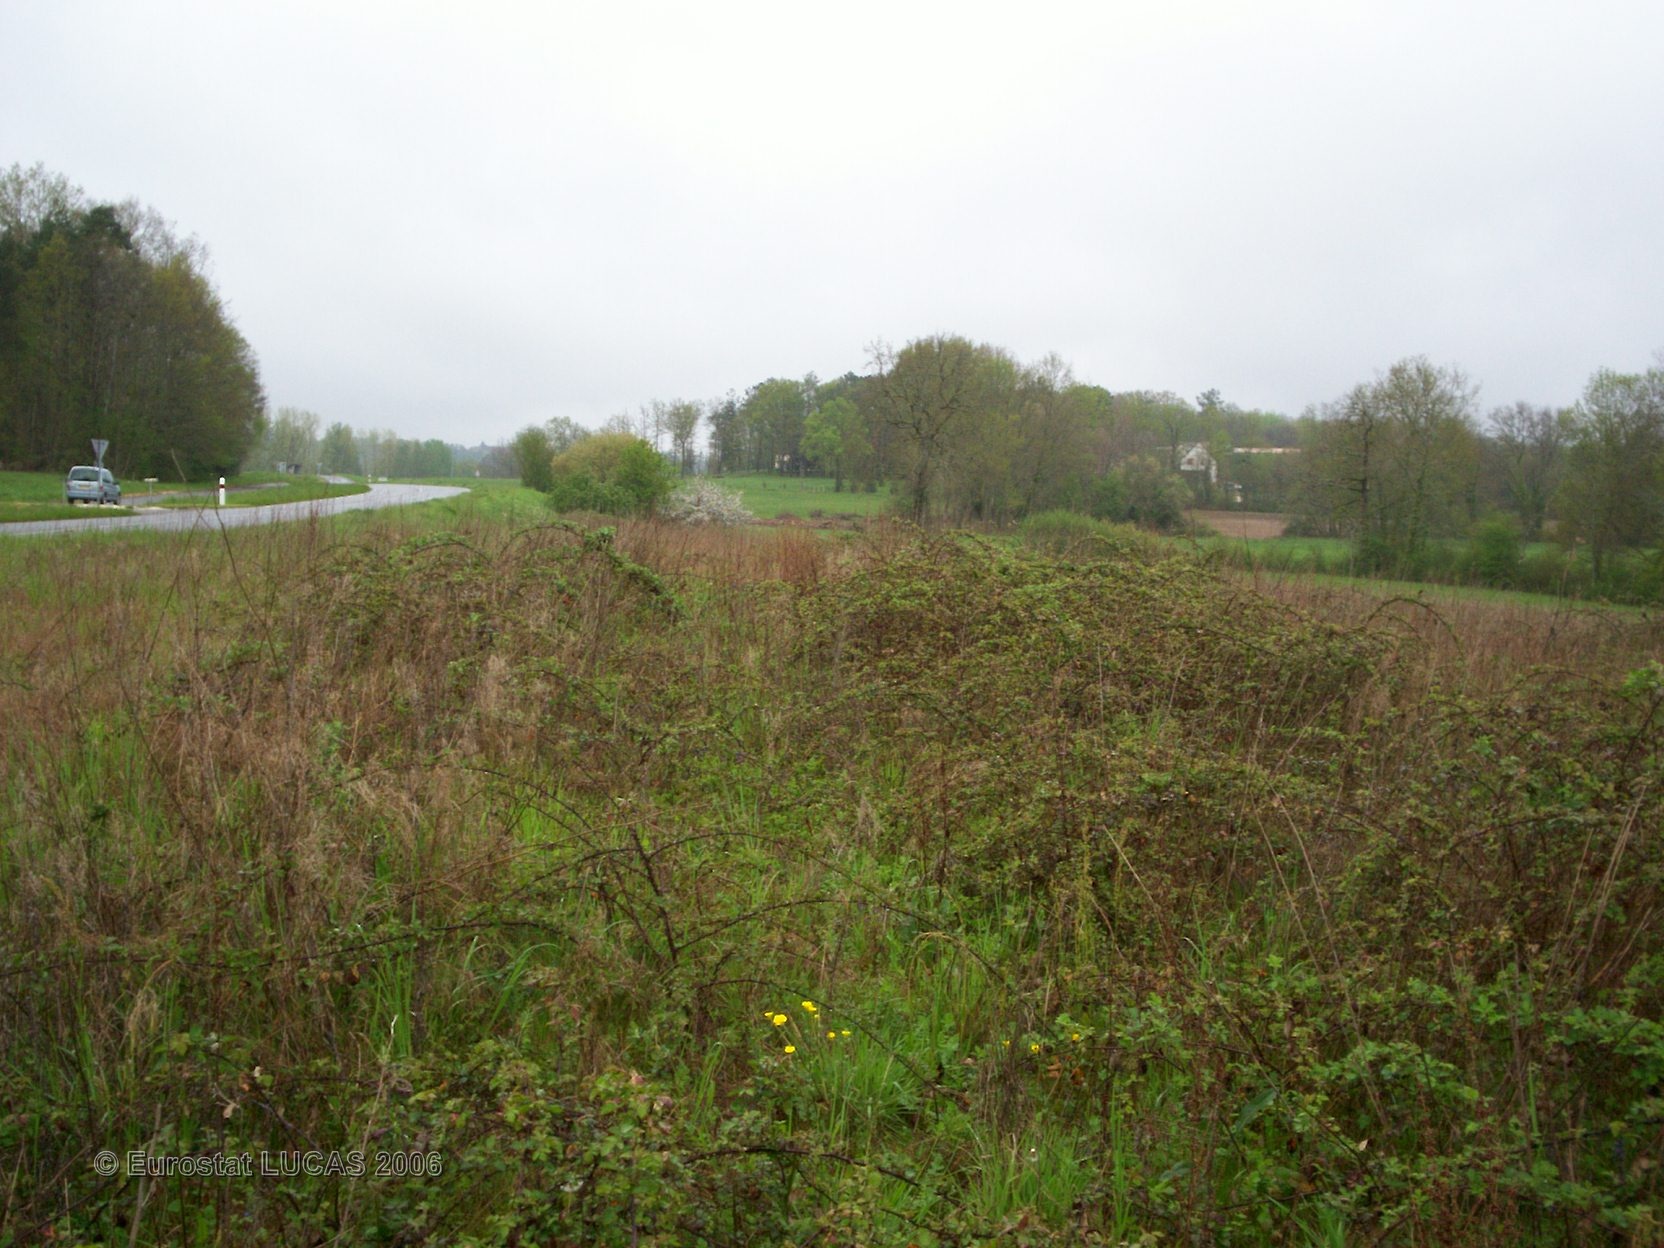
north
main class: Grassland
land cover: Grassland with sparse tree/shrub cover
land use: Unused
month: April
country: FR
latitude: 45.3947
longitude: 0.6252
